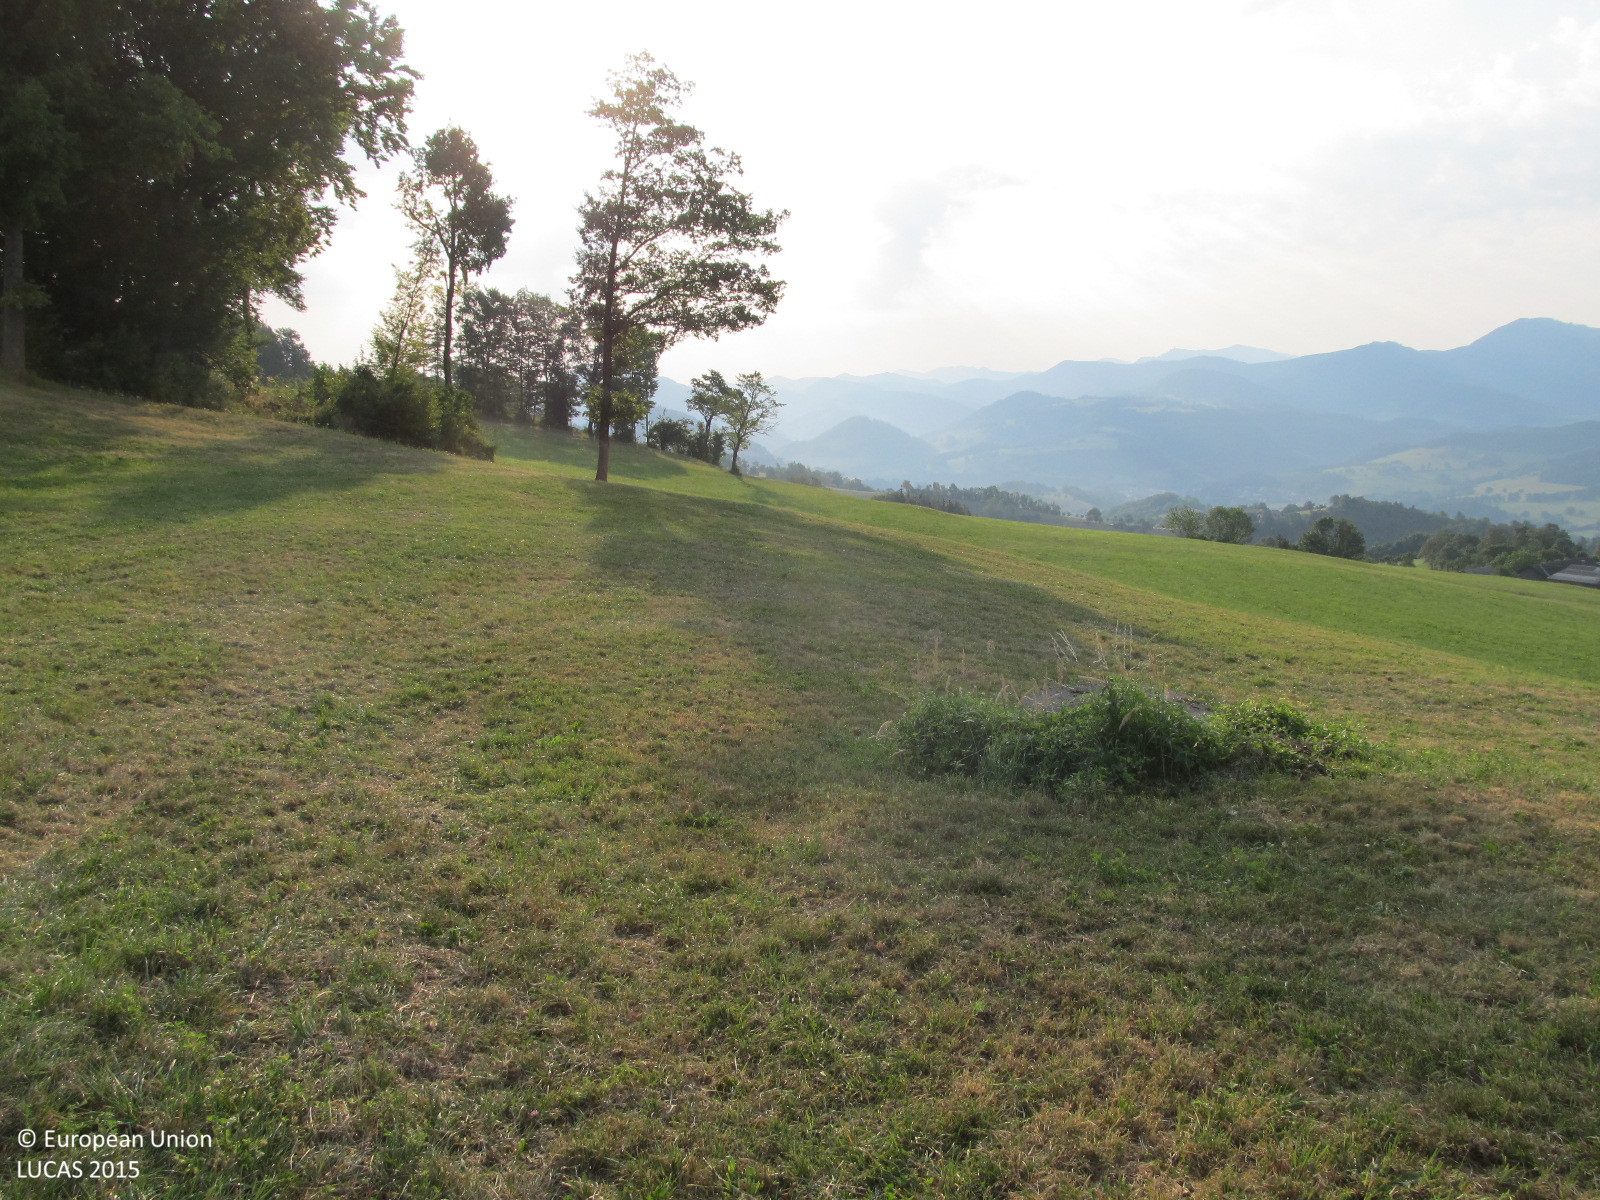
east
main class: Grassland
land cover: Grassland without tree/shrub cover
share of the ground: > 75 %
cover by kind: herbaceous plants 100 %
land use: Agriculture (excluding fallow land and kitchen gardens)
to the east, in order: Grassland without tree/shrub cover; Single bushes/trees; Grassland without tree/shrub cover; Tracks; Grassland without tree/shrub cover; Single bushes/trees; Grassland without tree/shrub cover; Fences; Grassland without tree/shrub cover; Broadleaved woodland; Grassland without tree/shrub cover
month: August
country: AT
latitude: 48.0381
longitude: 15.3801
